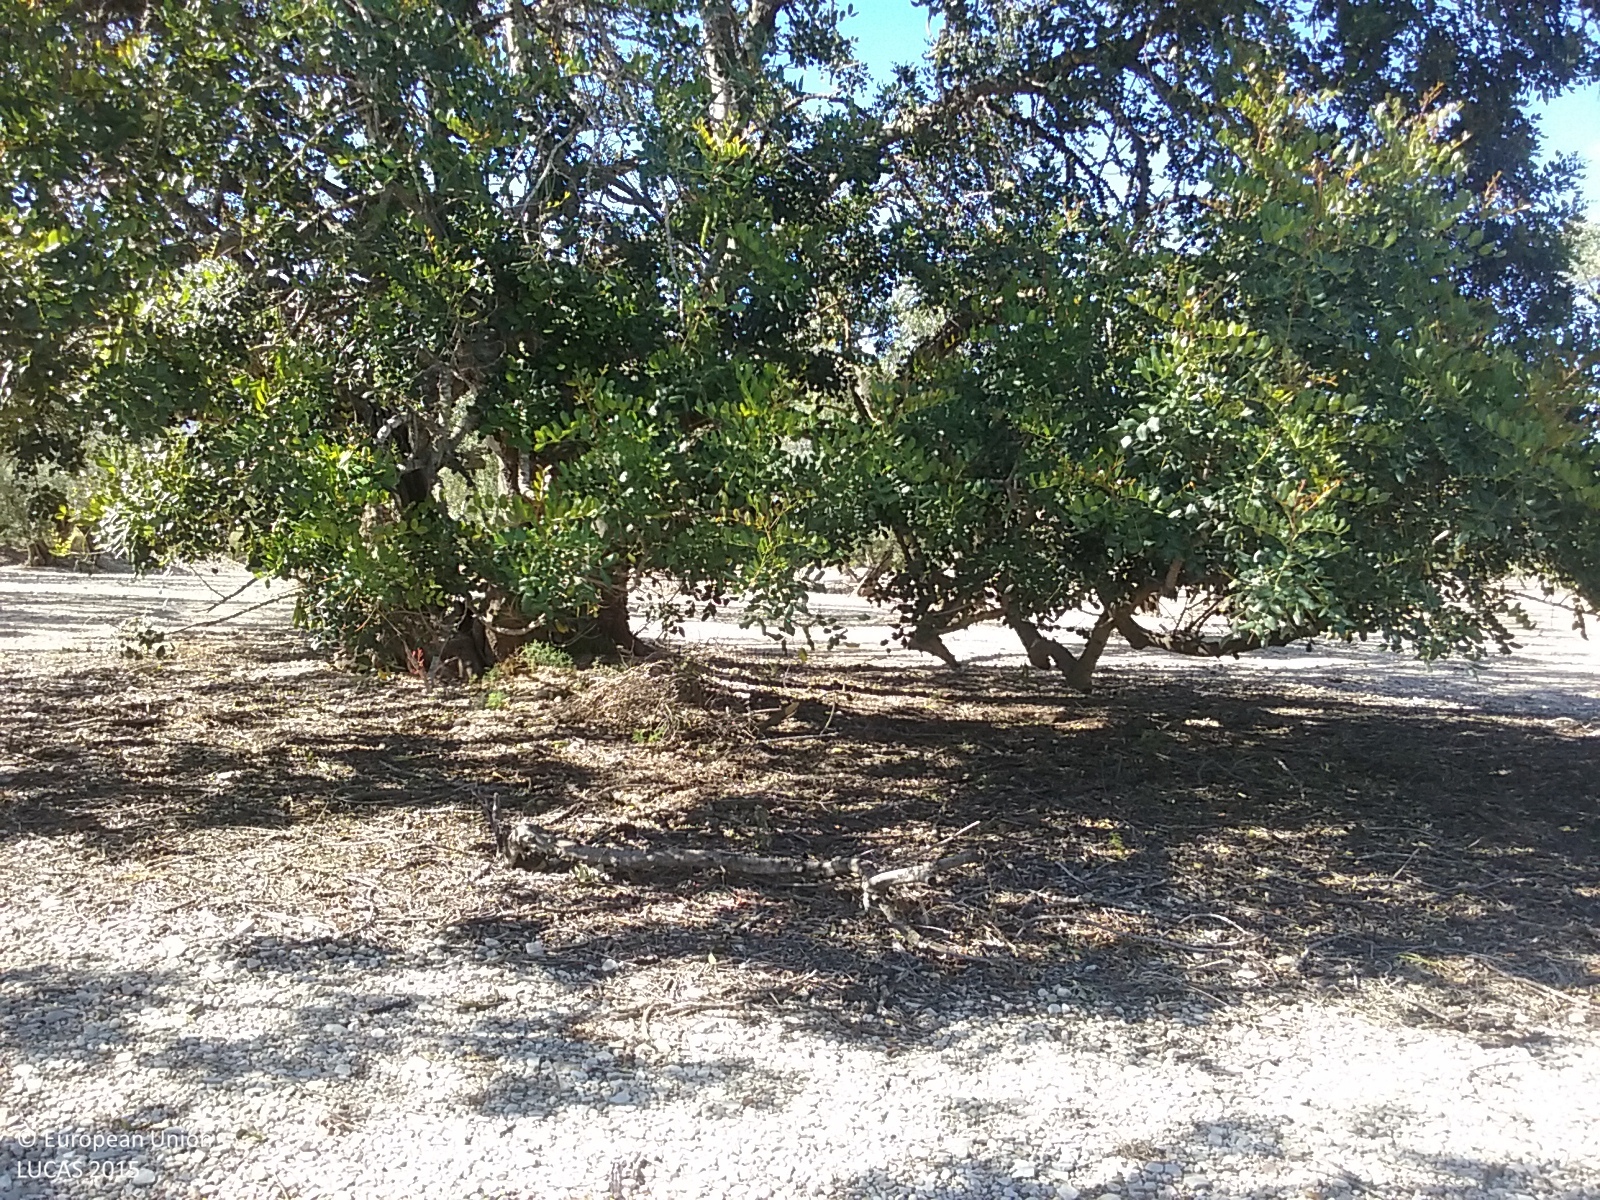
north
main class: Cropland
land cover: Olive groves
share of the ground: 50 - 75 %
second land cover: Other bare soil
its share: > 75 %
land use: Agriculture (excluding fallow land and kitchen gardens)
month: May
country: ES
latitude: 40.7816
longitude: 0.4312
